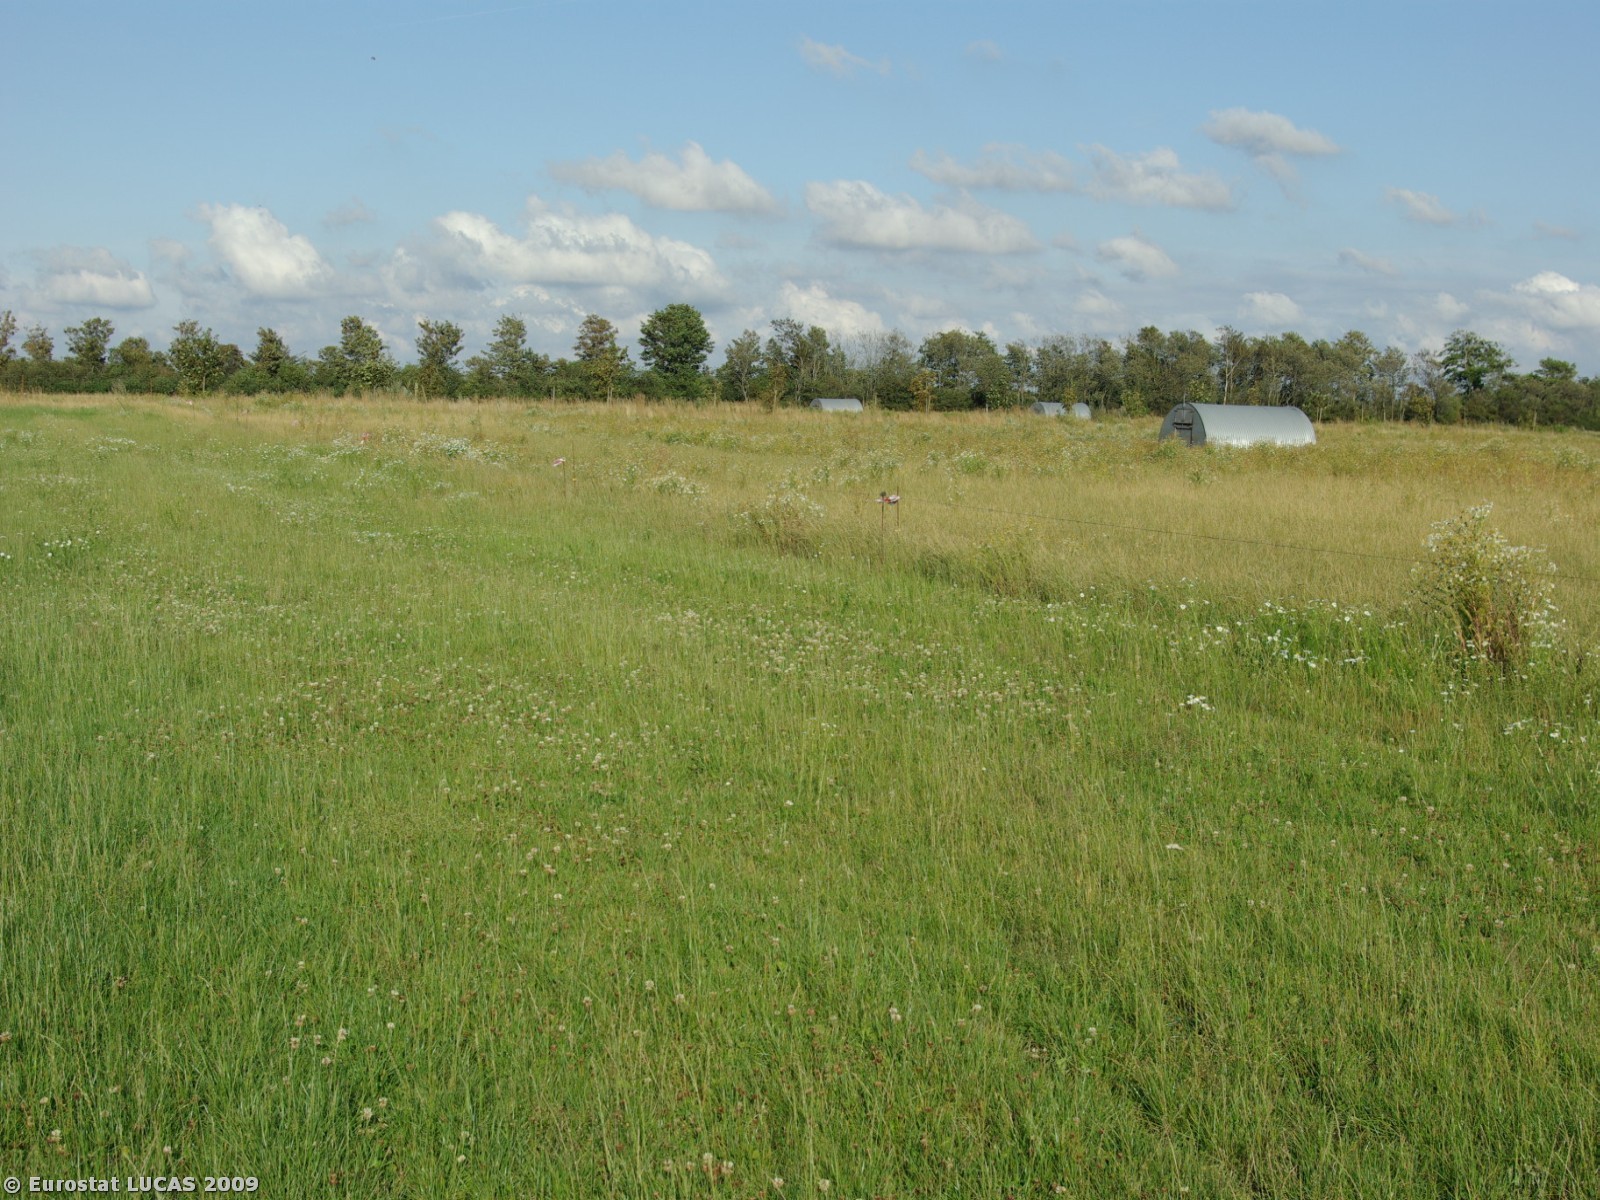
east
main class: Grassland
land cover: Grassland without tree/shrub cover
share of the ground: > 75 %
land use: Agriculture (excluding fallow land and kitchen gardens)
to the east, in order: Grassland without tree/shrub cover; Fences; Grassland without tree/shrub cover; Tracks; Grassland without tree/shrub cover; Fences; Grassland without tree/shrub cover; Fences; Broadleaved woodland; Grassland without tree/shrub cover
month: July
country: DK
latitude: 55.1763
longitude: 8.8861
